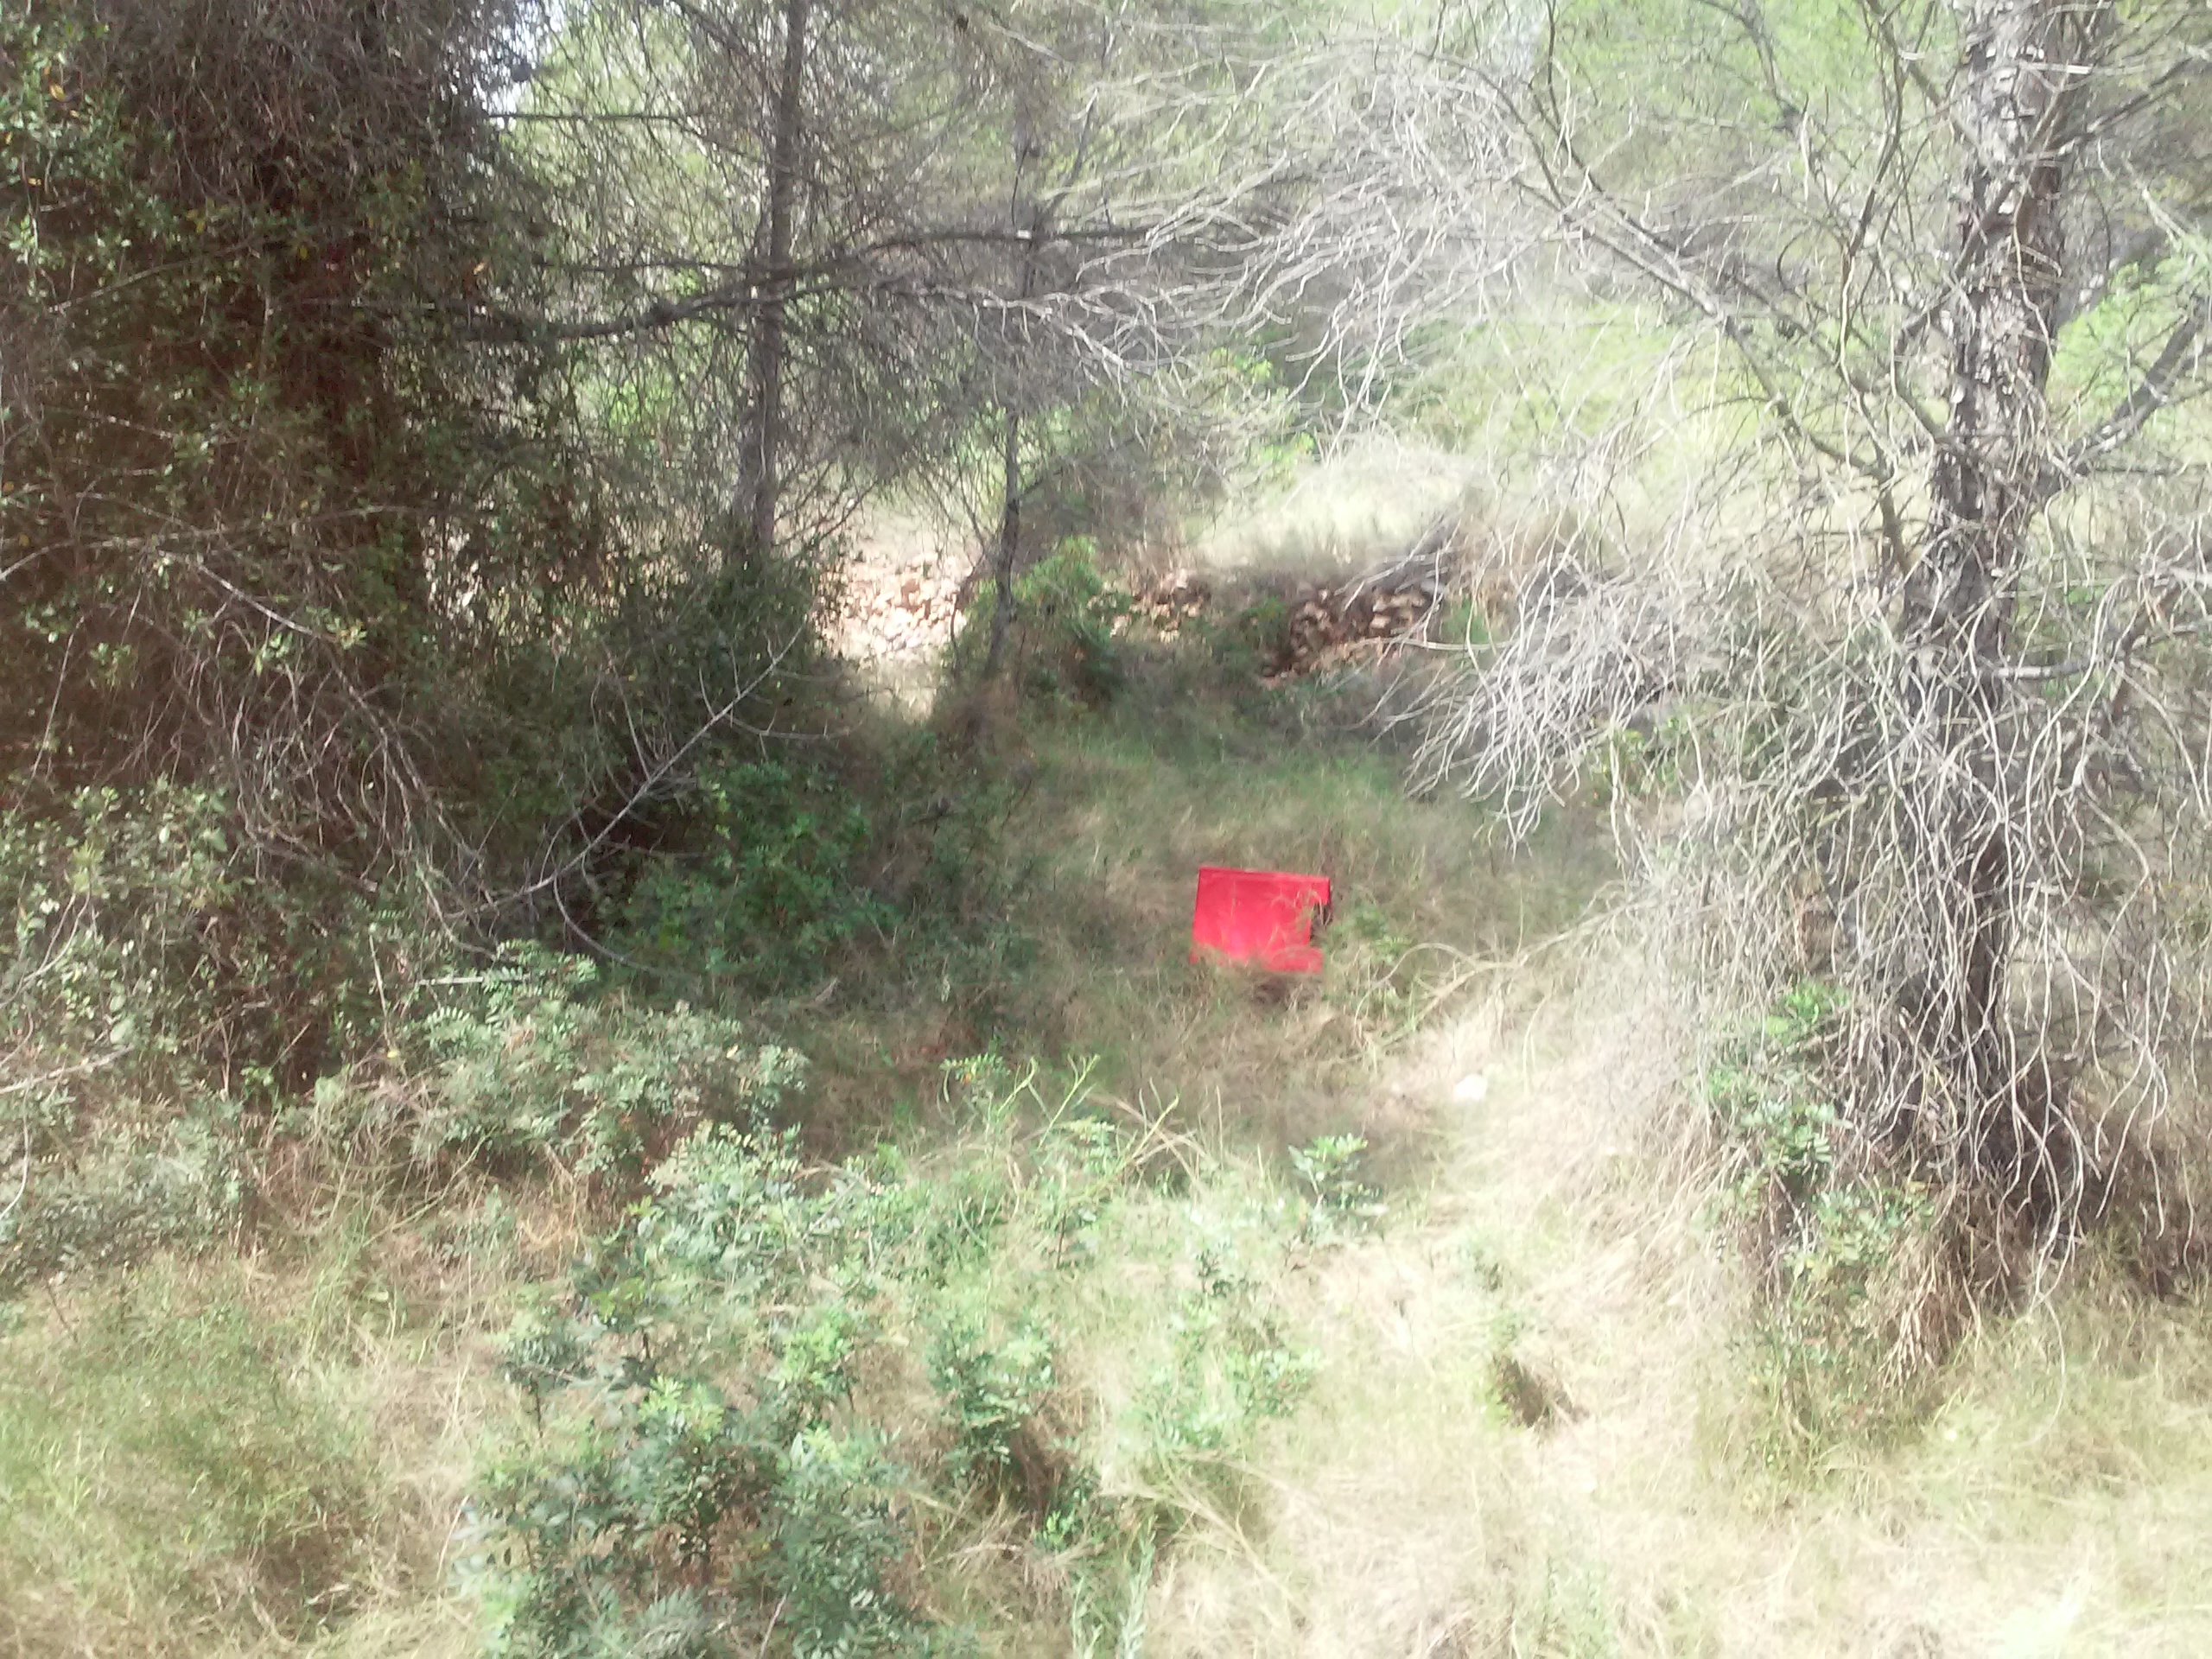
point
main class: Woodland
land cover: Pine dominated coniferous woodland
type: coniferous forest of the mediterranean region
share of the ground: 25 - 50 %
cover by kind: coniferous forest trees 35 %, shrubs 25 %, herbaceous plants 15 %, broadleaved forest trees 10 %, lichens and mosses 10 %, consolidated bare surface 5 %
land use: Semi-natural and natural areas not in use
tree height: < 5 m
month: July
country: ES
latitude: 41.1335
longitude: 1.2858
